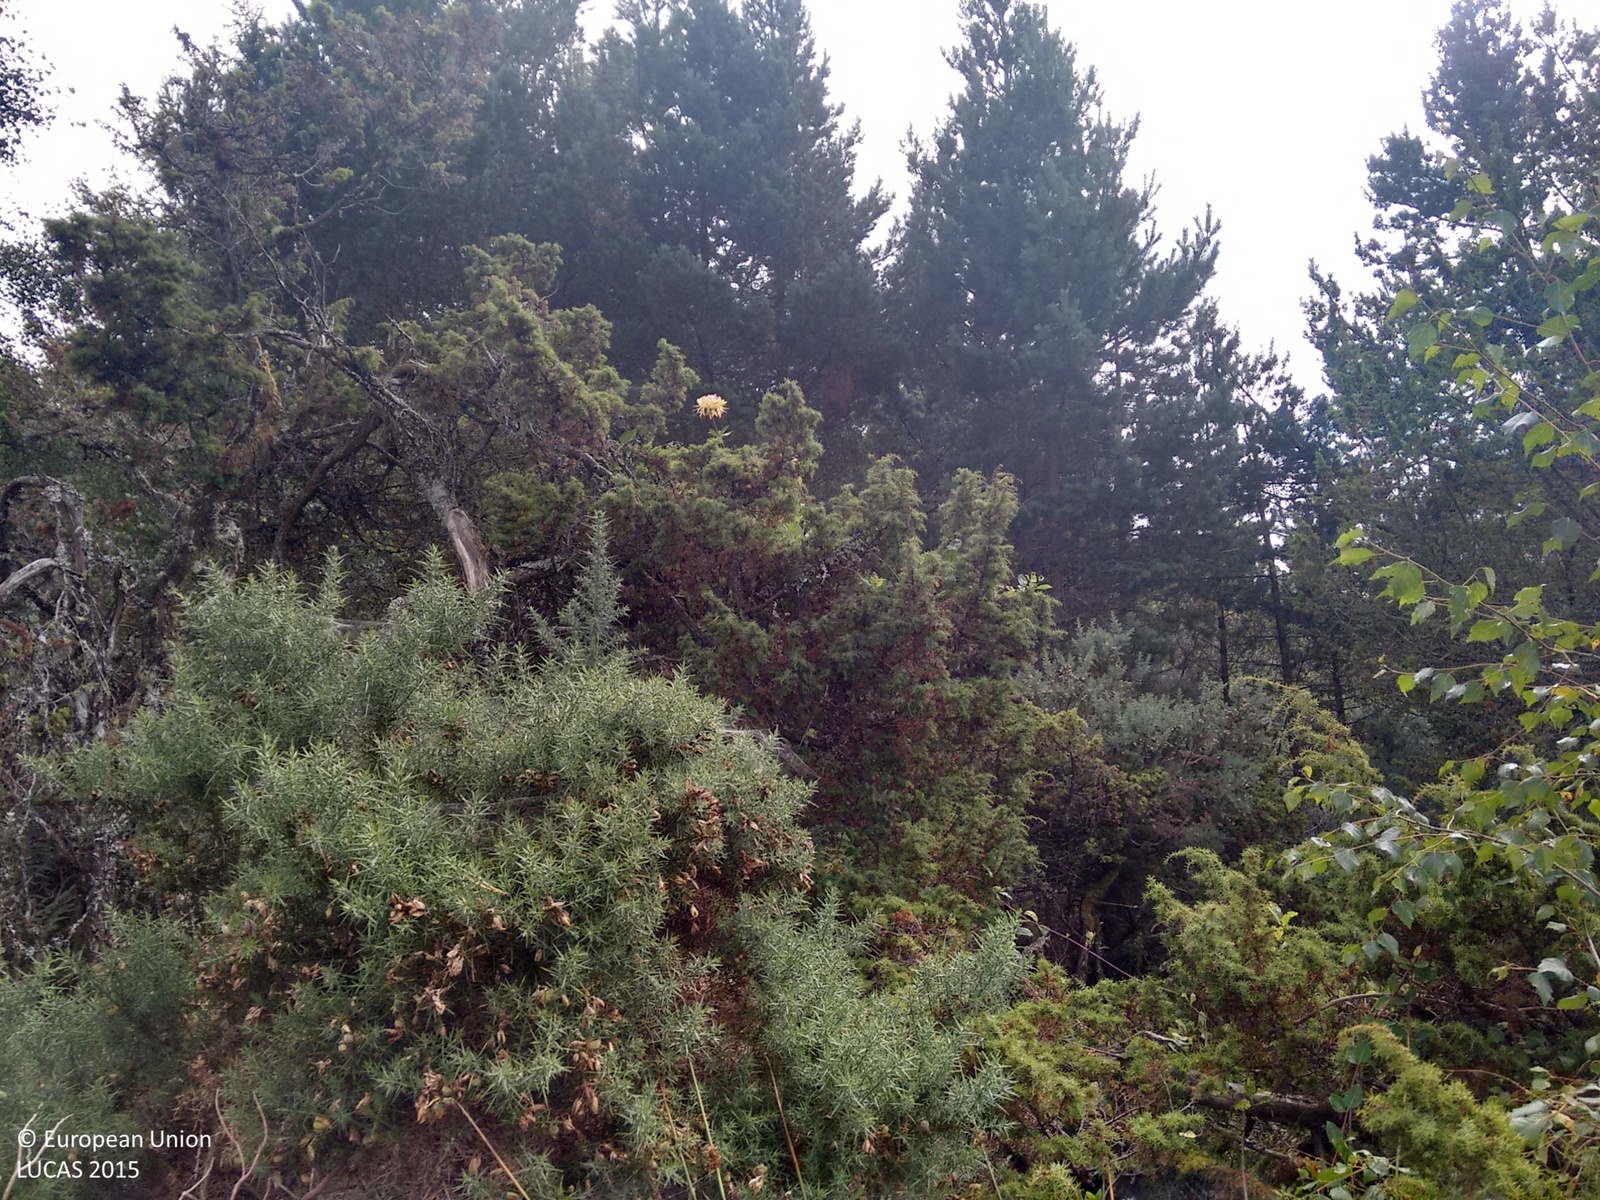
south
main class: Woodland
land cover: Other mixed woodland
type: exotic forest
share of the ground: > 75 %
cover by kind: coniferous forest trees 45 %, broadleaved forest trees 30 %, shrubs 25 %
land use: Agriculture (excluding fallow land and kitchen gardens)
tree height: > 5 m
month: September
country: GB
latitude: 57.4135
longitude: -4.4576
